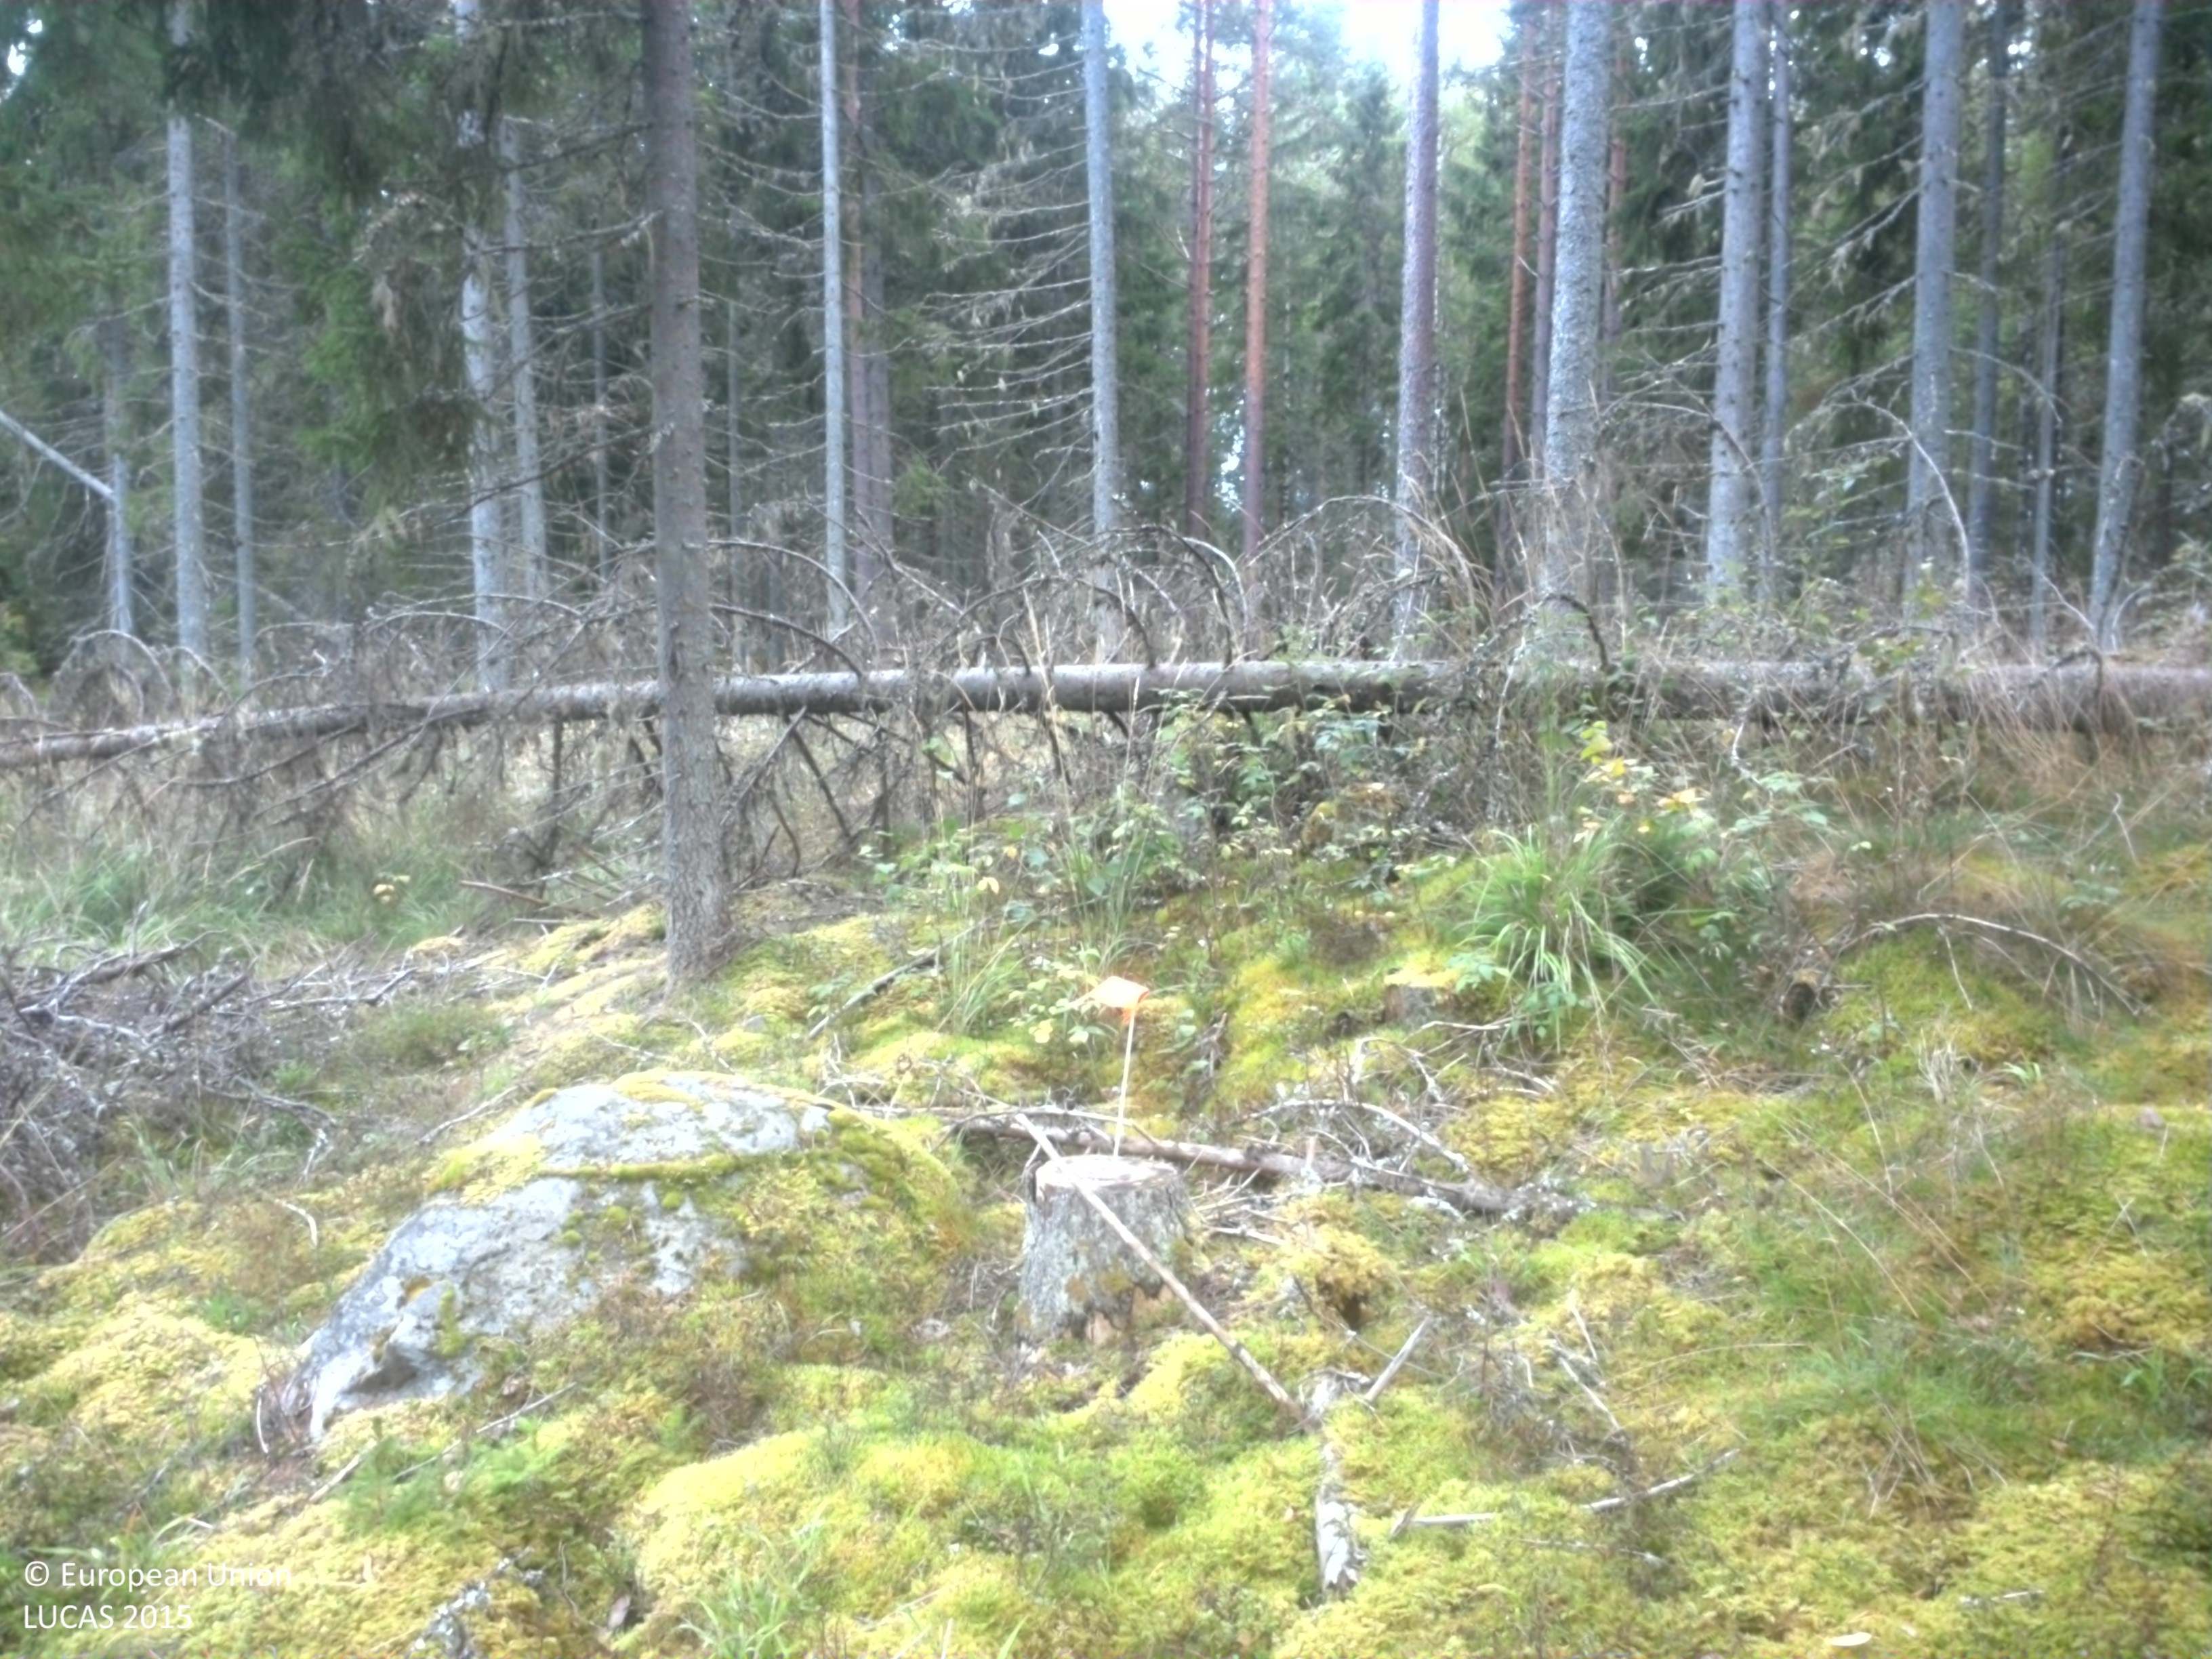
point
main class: Woodland
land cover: Spruce dominated coniferous woodland
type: boreal forest
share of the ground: 50 - 75 %
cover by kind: coniferous forest trees 60 %, lichens and mosses 25 %, herbaceous plants 10 %, shrubs 5 %
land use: Forestry
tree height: > 5 m
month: September
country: SE
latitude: 59.6165
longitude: 15.6452
